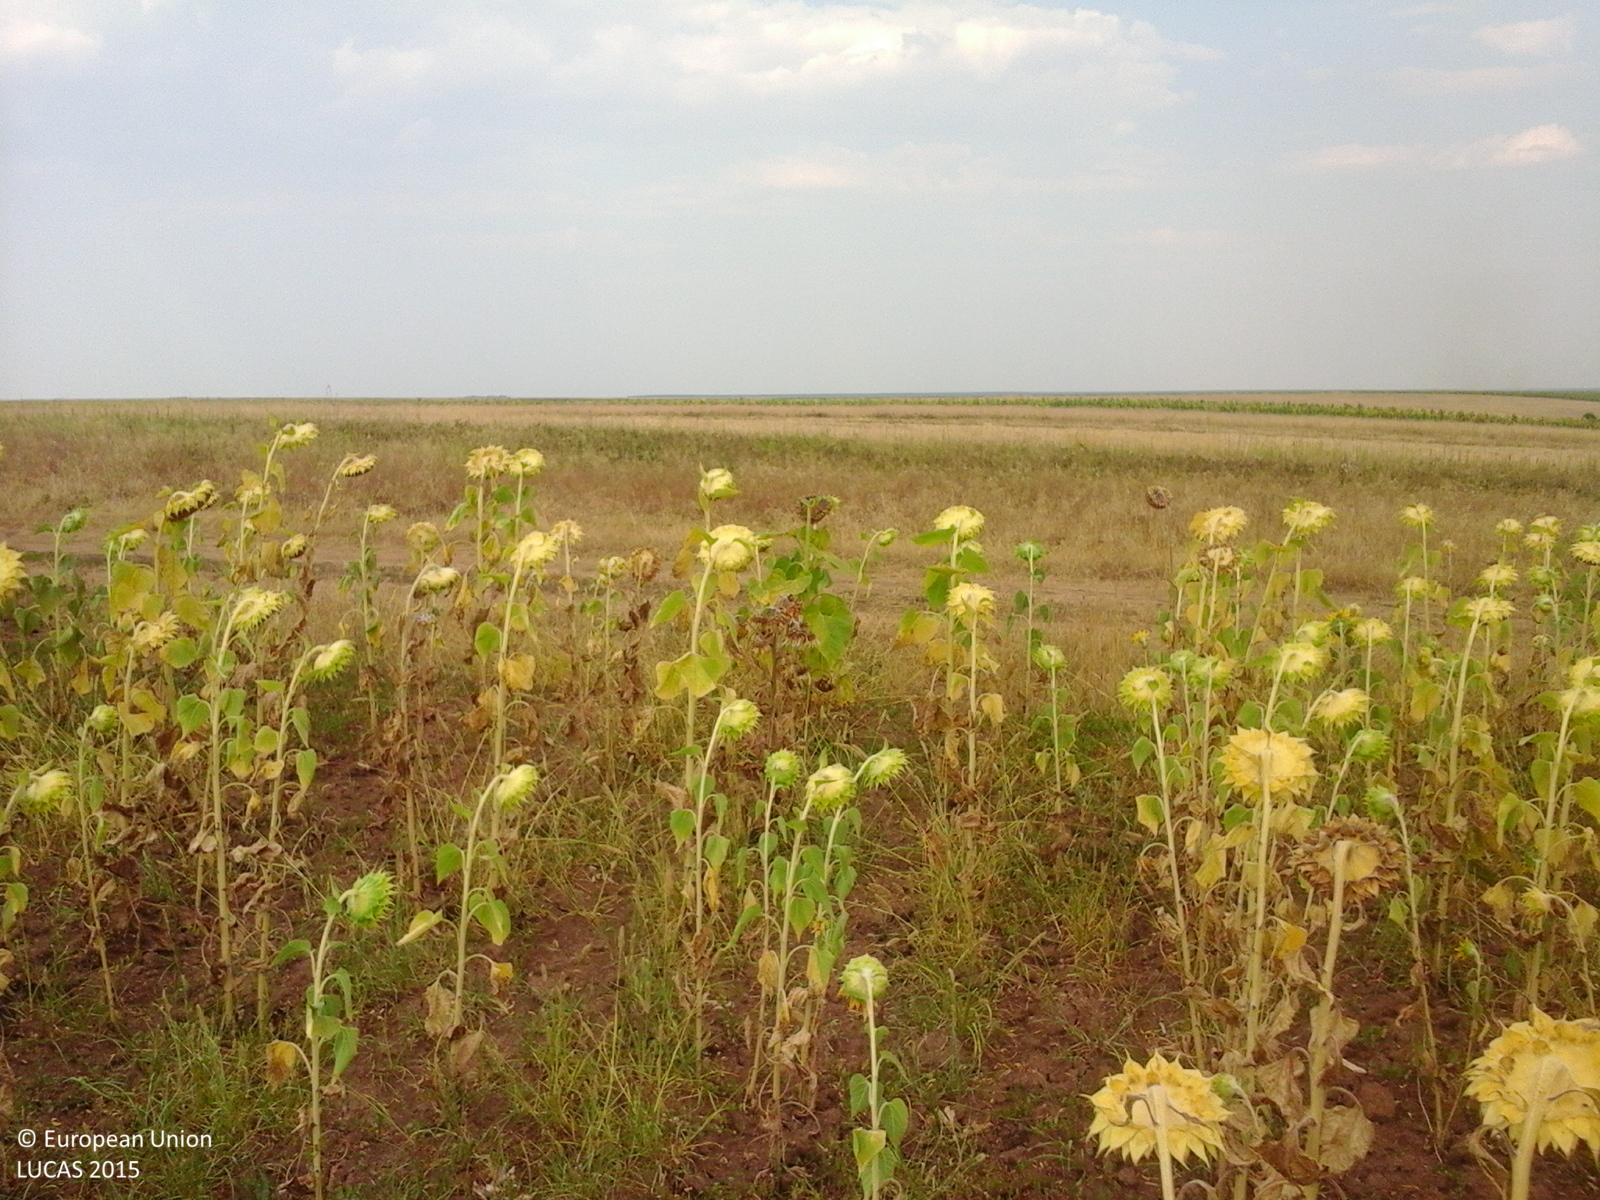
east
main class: Cropland
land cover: Sunflower
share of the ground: > 75 %
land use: Agriculture (excluding fallow land and kitchen gardens)
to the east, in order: Sunflower; Grass margins; Tracks; Spontaneously vegetated surfaces; Common wheat
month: August
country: RO
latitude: 44.3517
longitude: 23.1309
